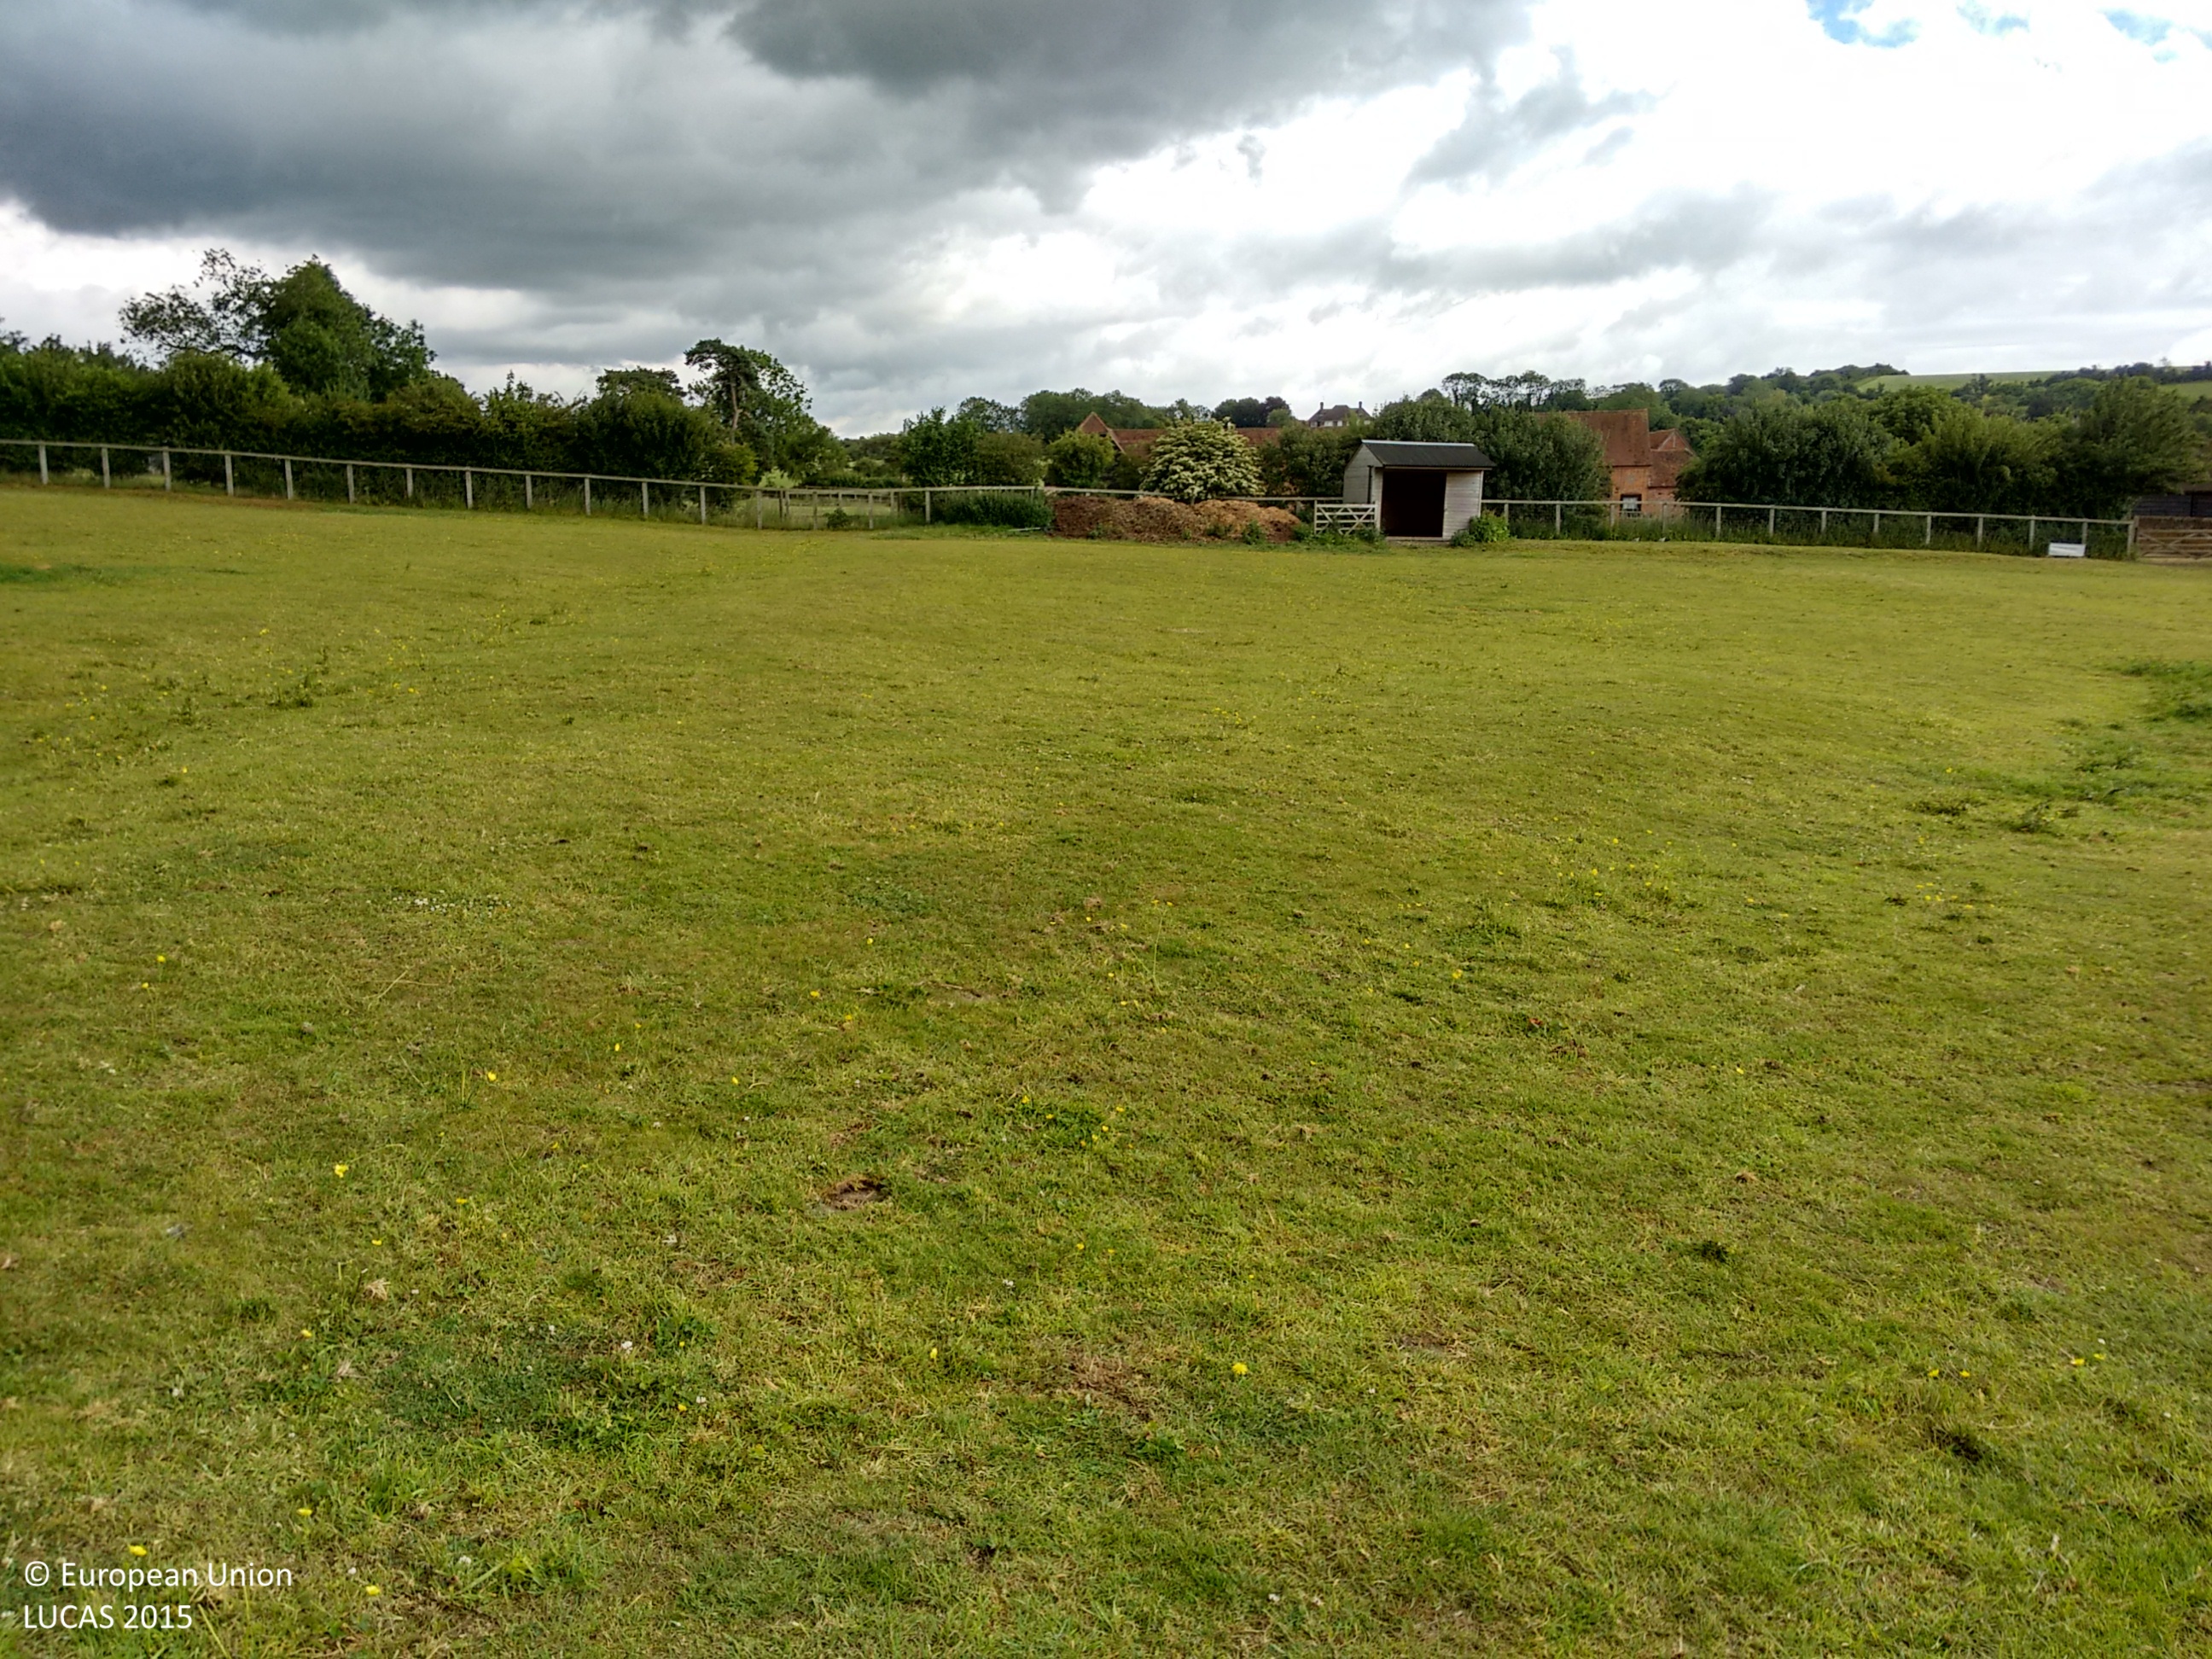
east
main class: Grassland
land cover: Grassland without tree/shrub cover
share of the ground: > 75 %
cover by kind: herbaceous plants 100 %
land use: Agriculture (excluding fallow land and kitchen gardens)
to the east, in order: Grassland without tree/shrub cover; Fences; Managed hedges; Grassland without tree/shrub cover; Artificial constructions in urban areas; Grass margins; Common wheat
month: June
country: GB
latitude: 51.5145
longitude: -1.2443
